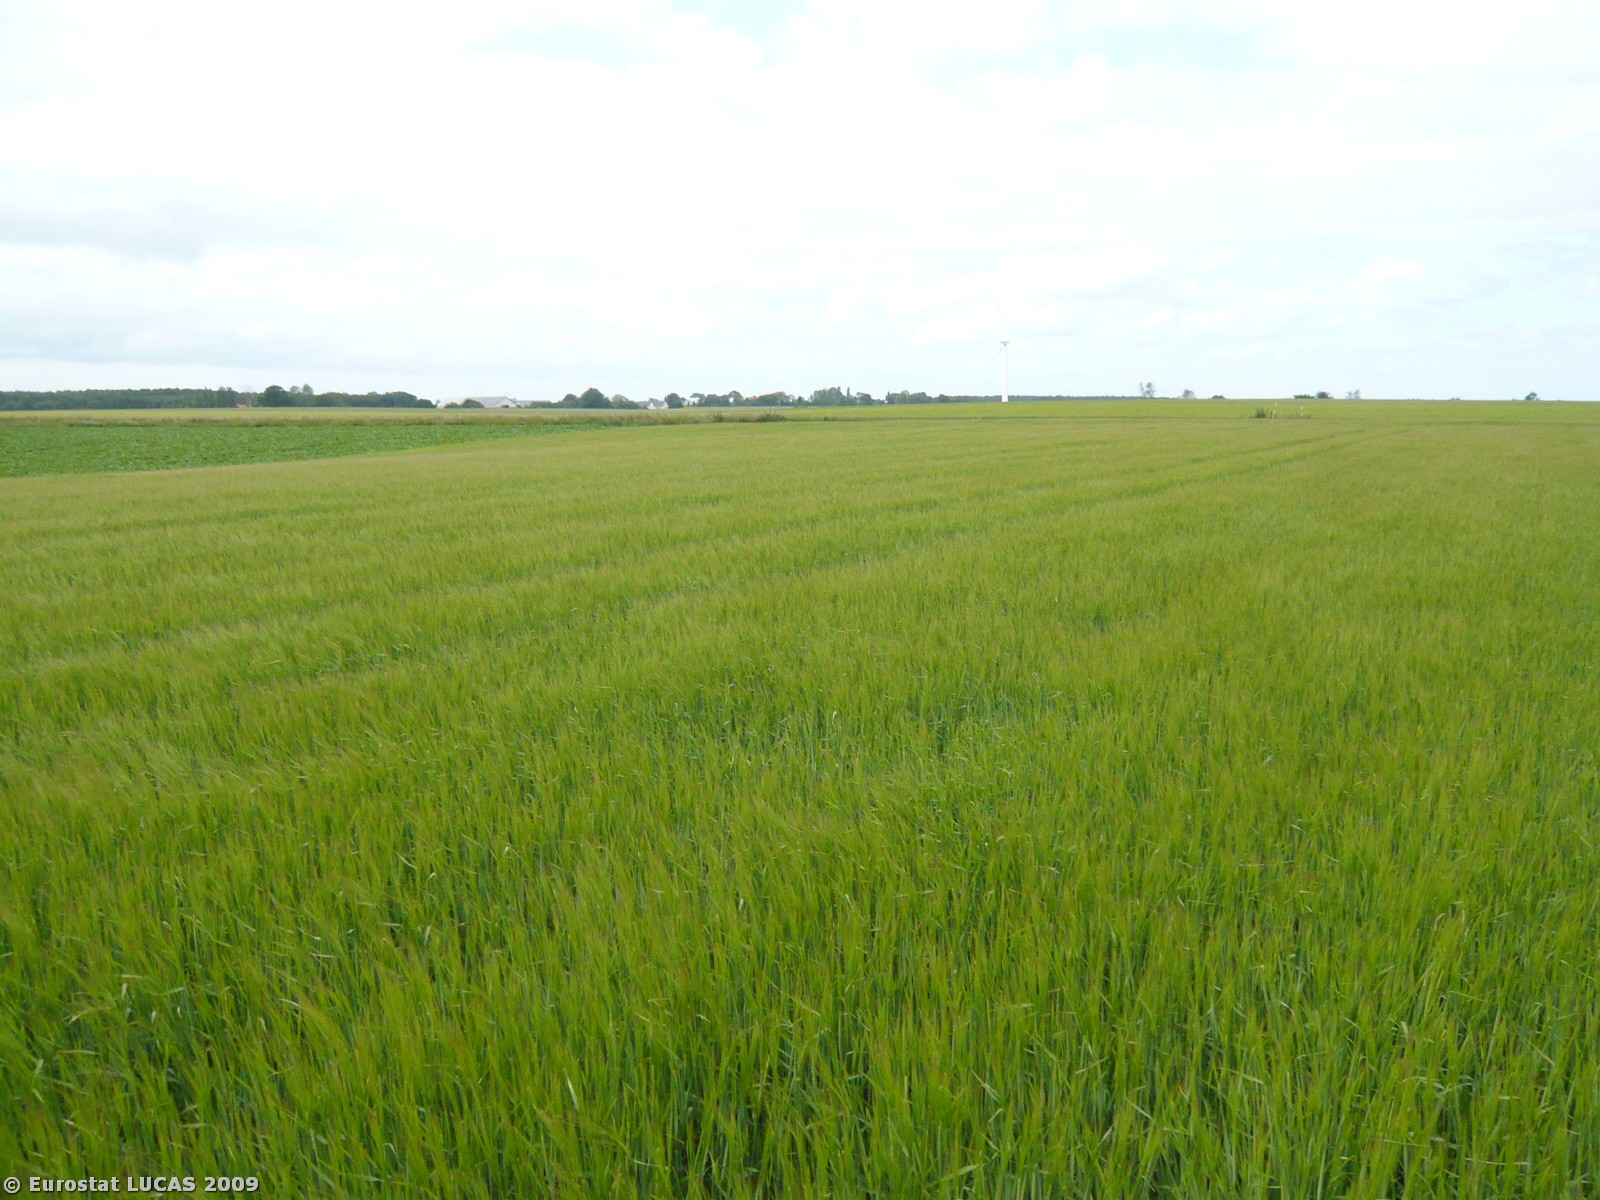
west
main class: Cropland
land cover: Barley
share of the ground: > 75 %
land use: Agriculture (excluding fallow land and kitchen gardens)
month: June
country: DK
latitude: 54.9415
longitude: 11.2323
